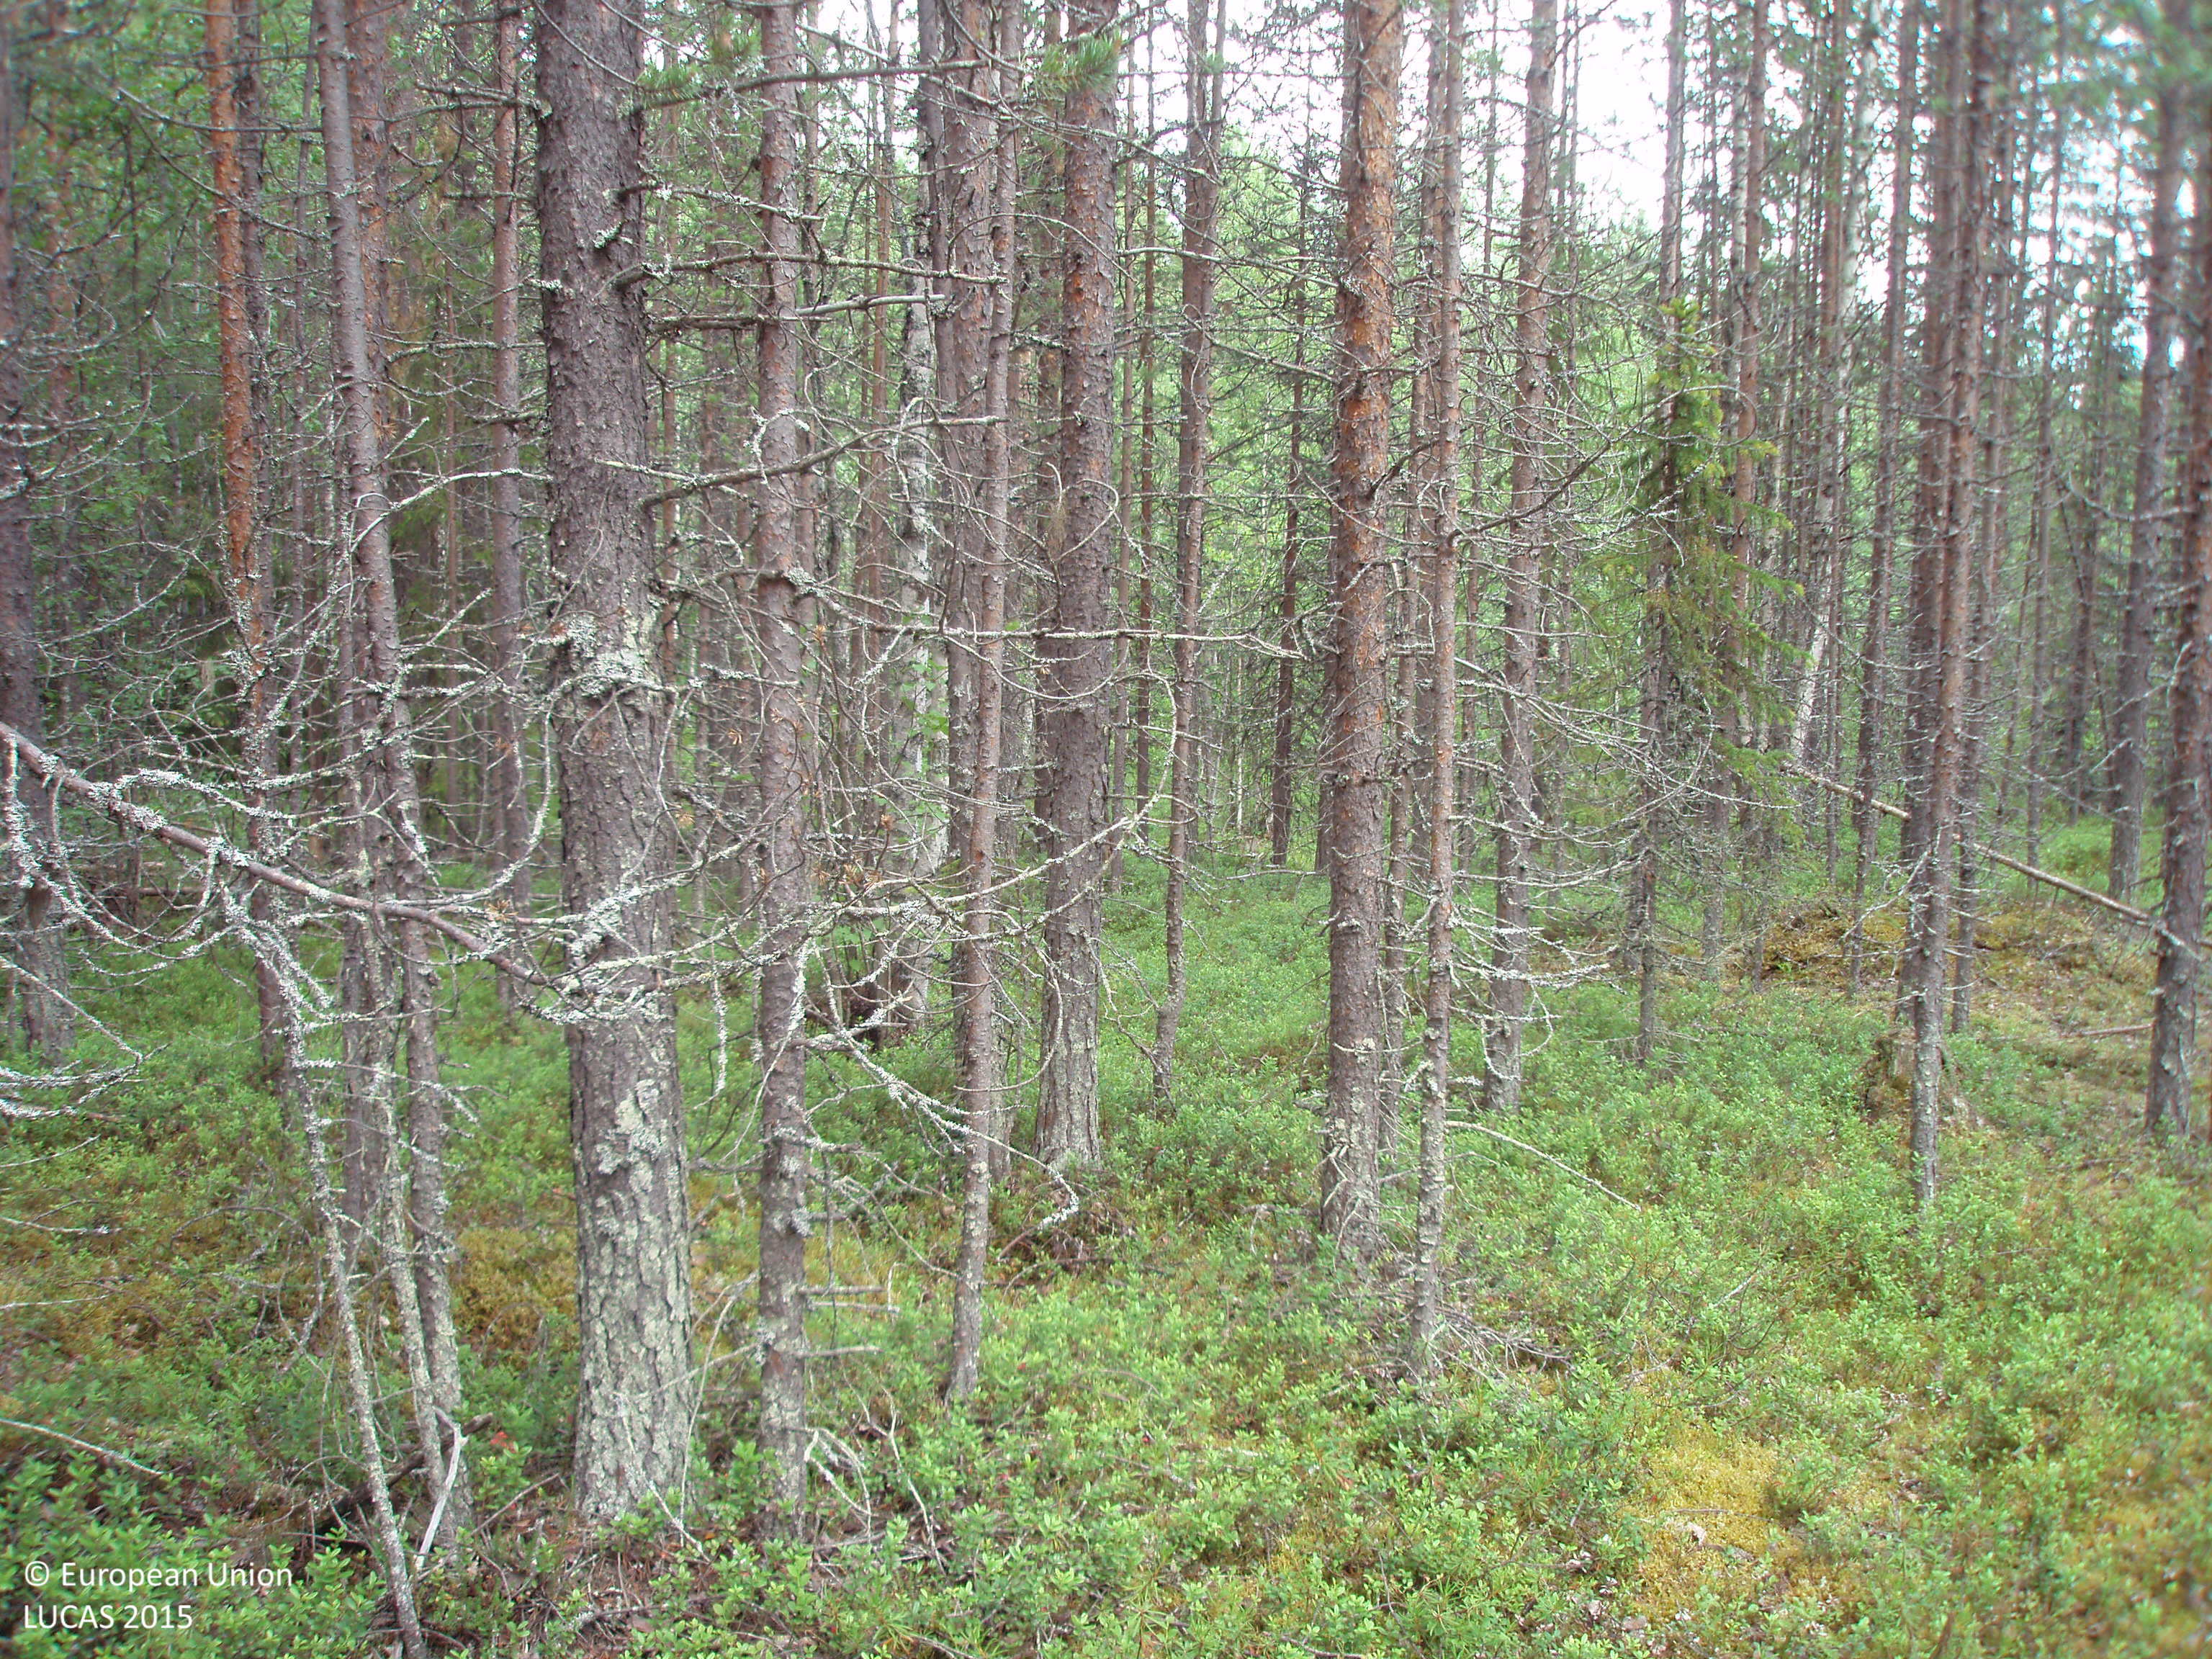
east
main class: Woodland
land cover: Pine dominated coniferous woodland
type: boreal forest
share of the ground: > 75 %
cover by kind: coniferous forest trees 70 %, shrubs 20 %, broadleaved forest trees 5 %, lichens and mosses 5 %
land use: Forestry
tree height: > 5 m
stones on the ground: 10 - 25 %
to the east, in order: Pine dominated coniferous woodland; Pine dominated mixed woodland; Ditches and canals; Paved roads, cycling and walking lanes; Ditches and canals; Grass margins; Other mixed woodland
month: July
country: FI
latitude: 66.8945
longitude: 28.4282
